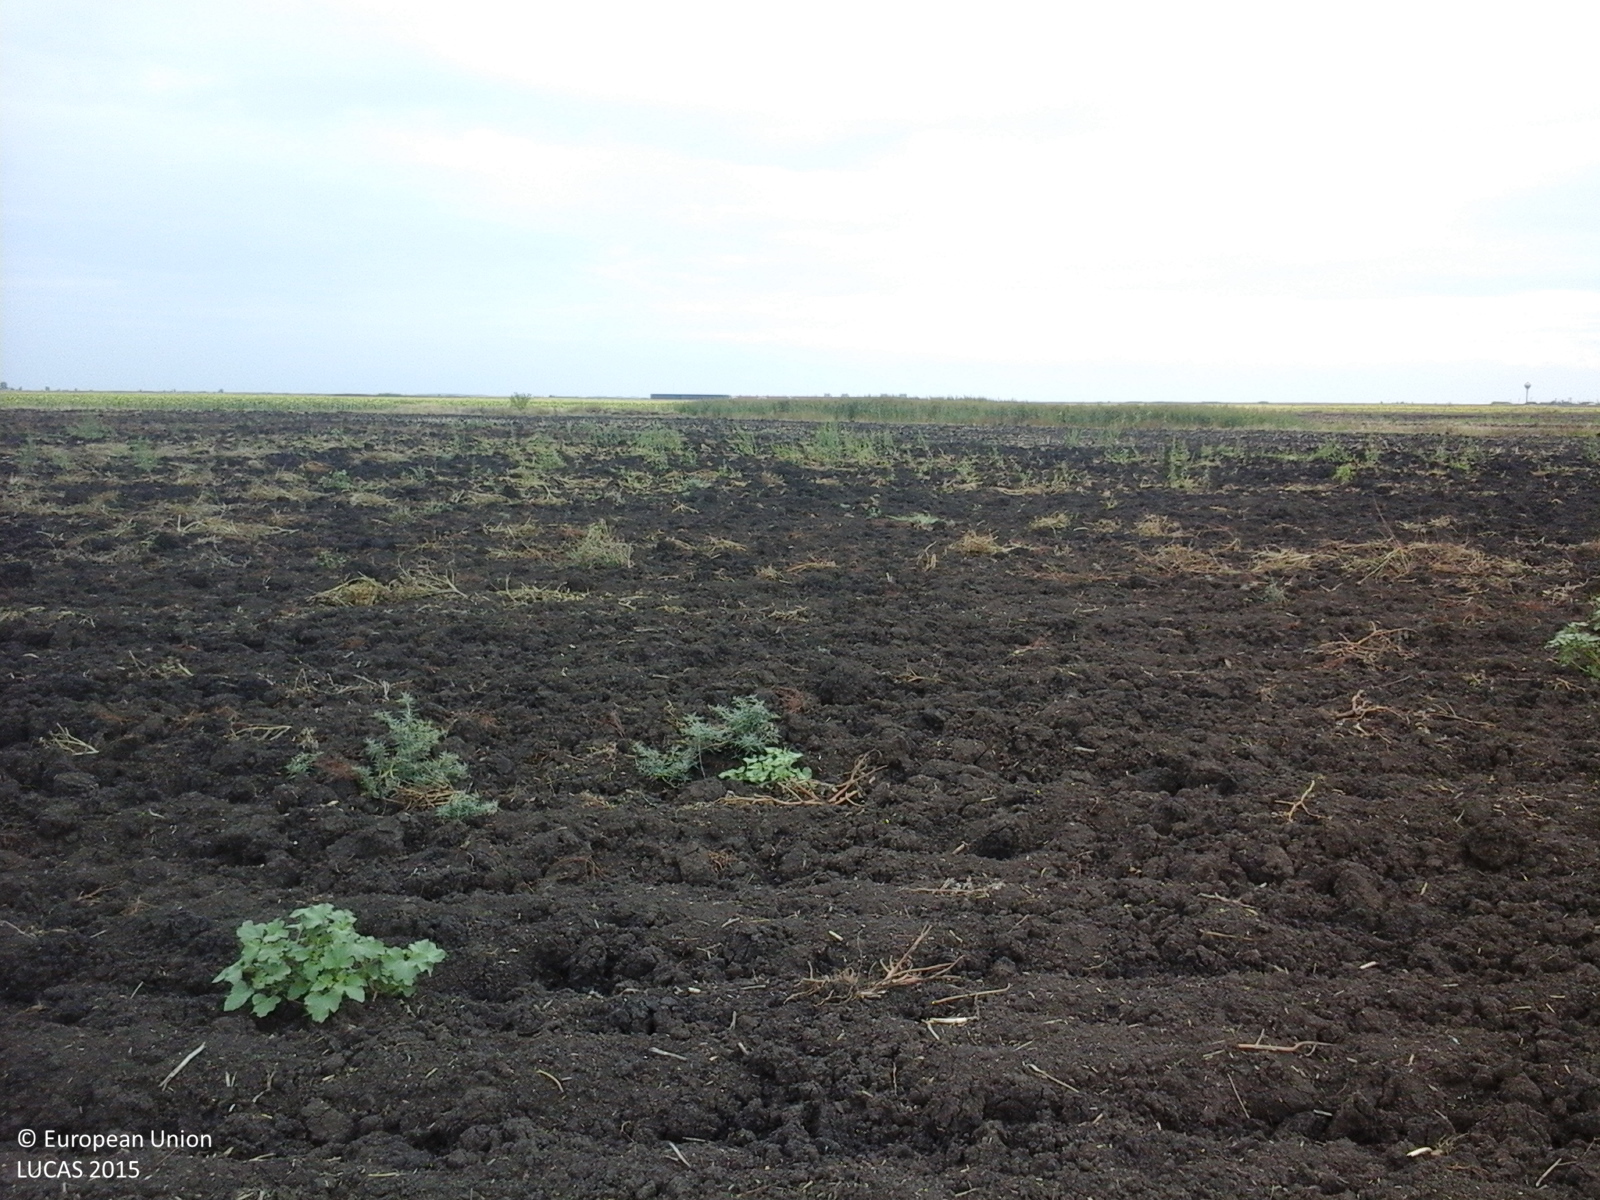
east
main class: Cropland
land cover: Rape and turnip rape
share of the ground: < 10 %
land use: Agriculture (excluding fallow land and kitchen gardens)
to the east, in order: Rape and turnip rape; Tracks; Grass margins; Ditches and canals; Grass margins; Rape and turnip rape; Grass margins; Ditches and canals; Grass margins; Sunflower
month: August
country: RO
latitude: 45.9918
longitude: 20.5466
